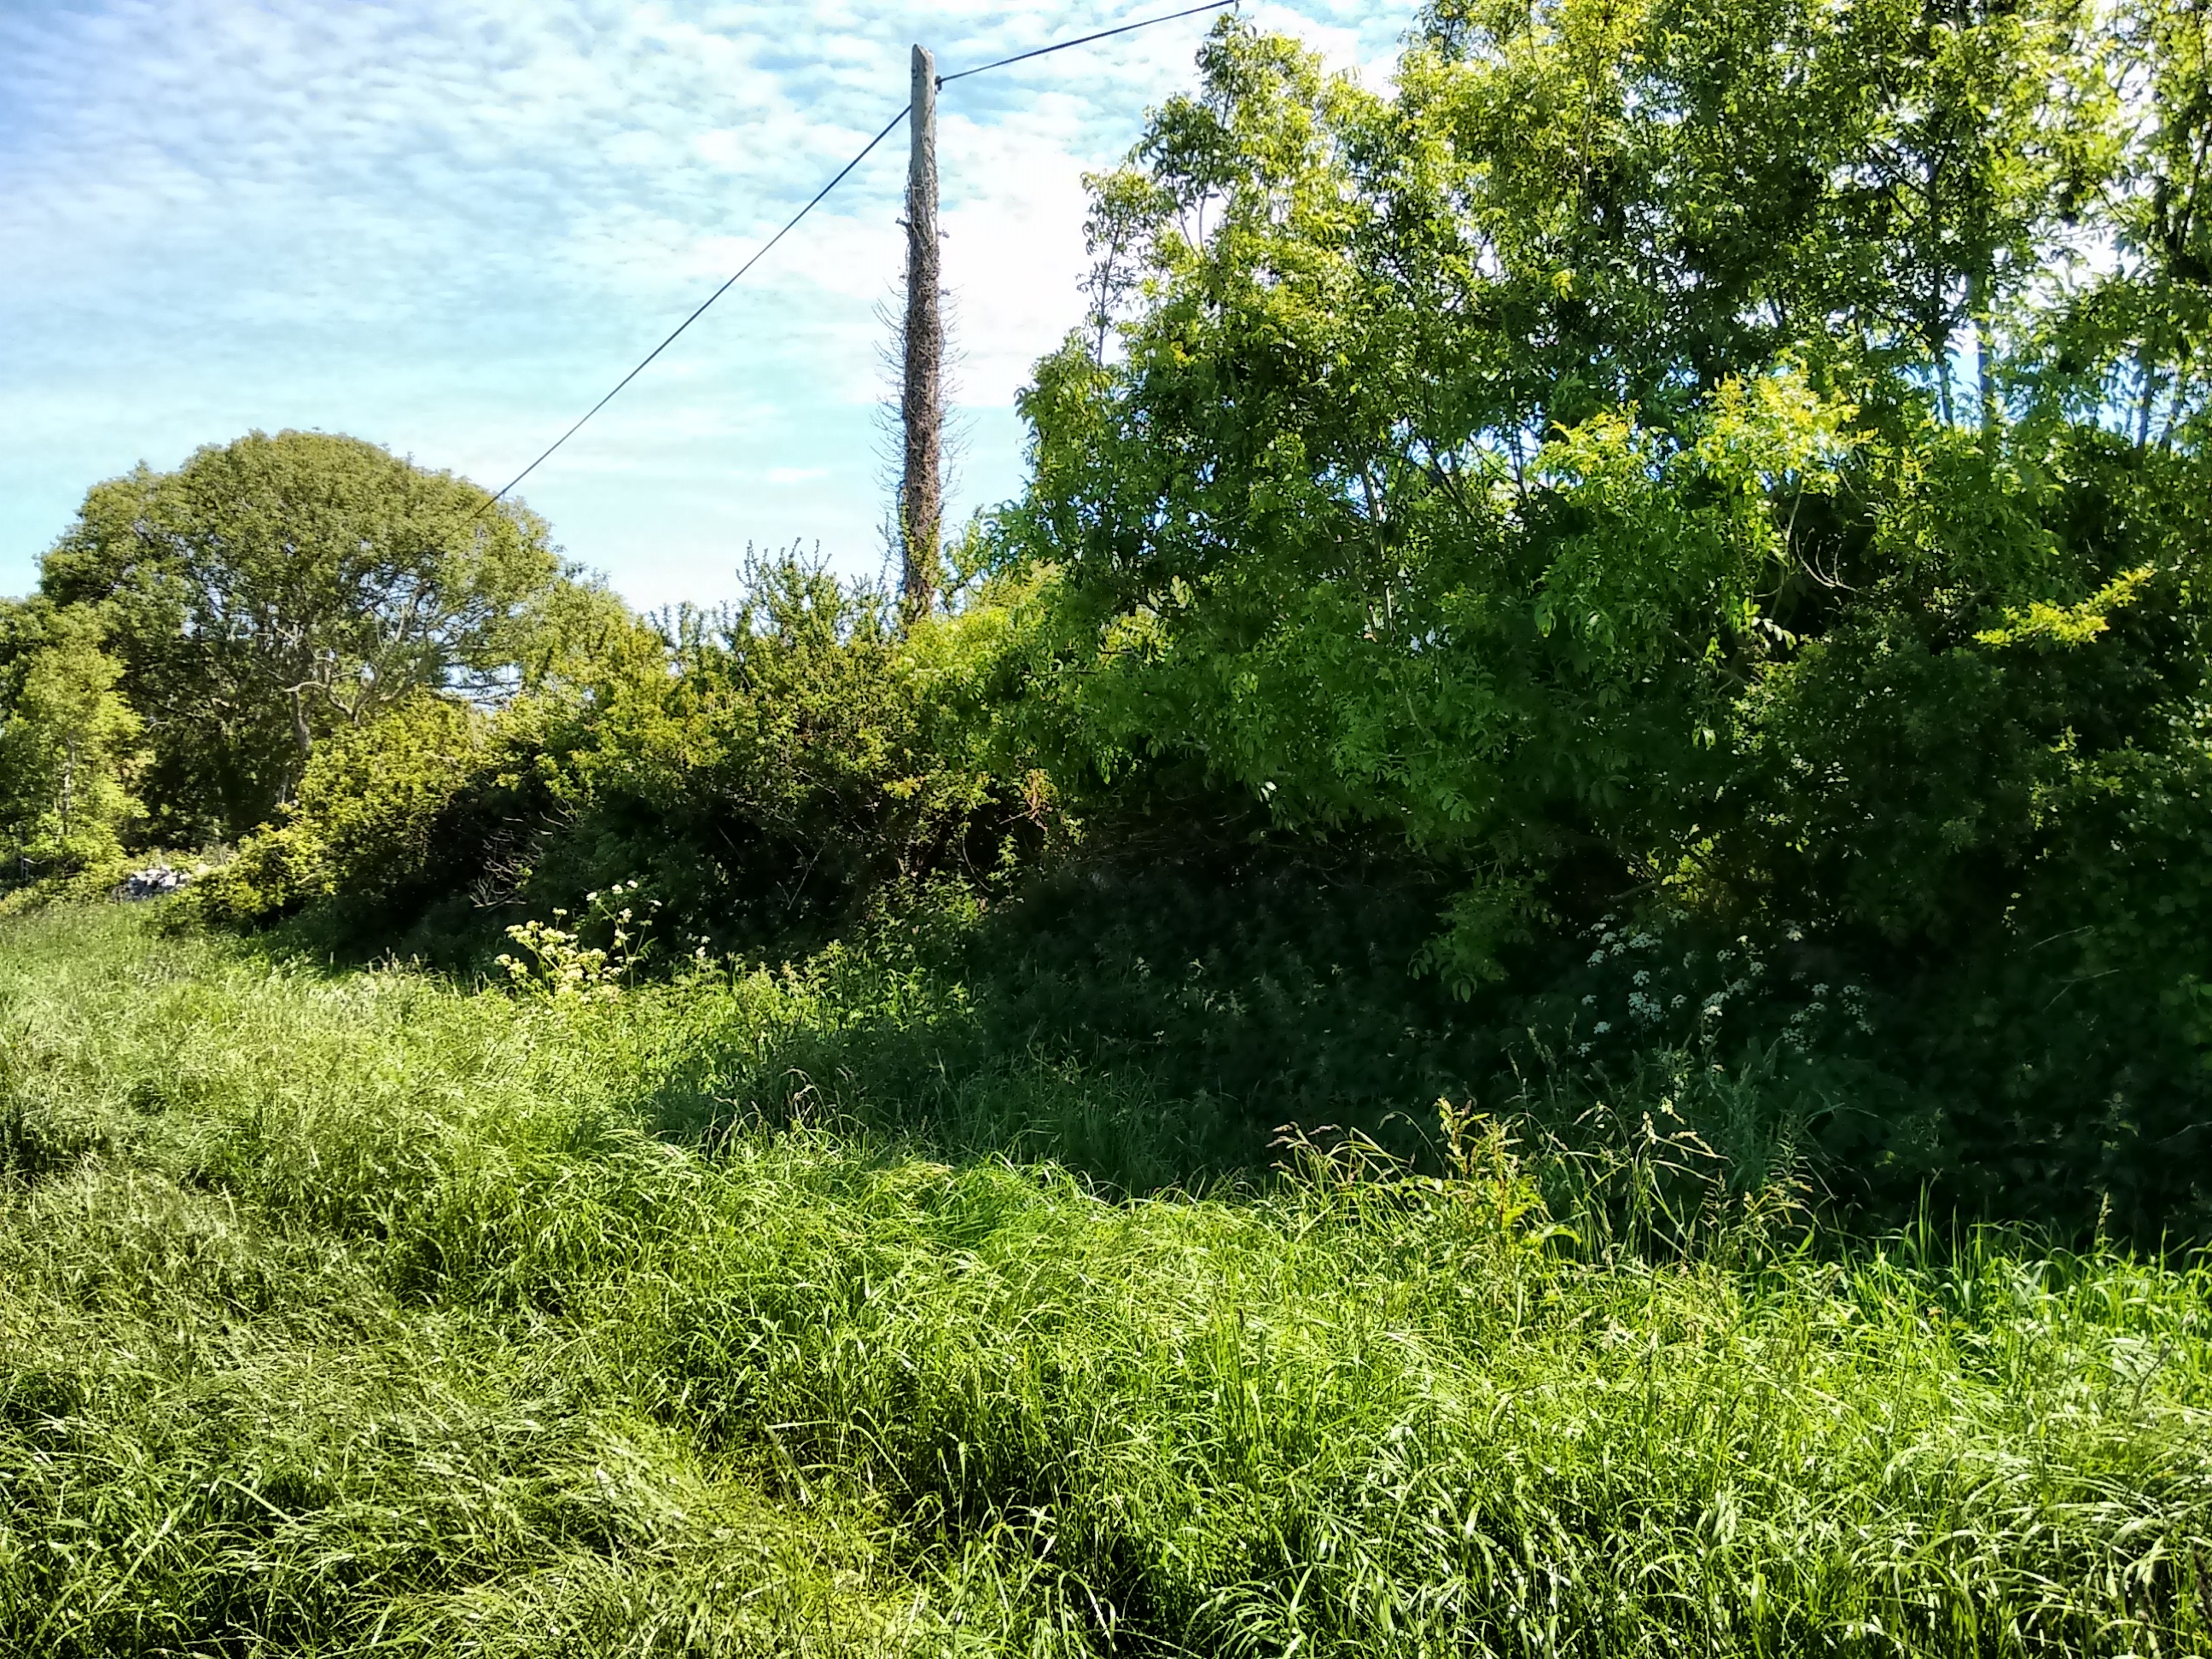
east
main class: Grassland
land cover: Grassland without tree/shrub cover
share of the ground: > 75 %
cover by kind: herbaceous plants 100 %
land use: Agriculture (excluding fallow land and kitchen gardens)
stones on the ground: < 10 %
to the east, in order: Grassland without tree/shrub cover; Electric lines; Managed hedges; Dry stone walls; Artificial constructions in urban areas; Grassland without tree/shrub cover; Broadleaved woodland; Electric lines; Paved roads, cycling and walking lanes; Dry stone walls; Electric lines; Broadleaved woodland; Grassland without tree/shrub cover; Fences
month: June
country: IE
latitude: 53.2523
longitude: -8.9613
